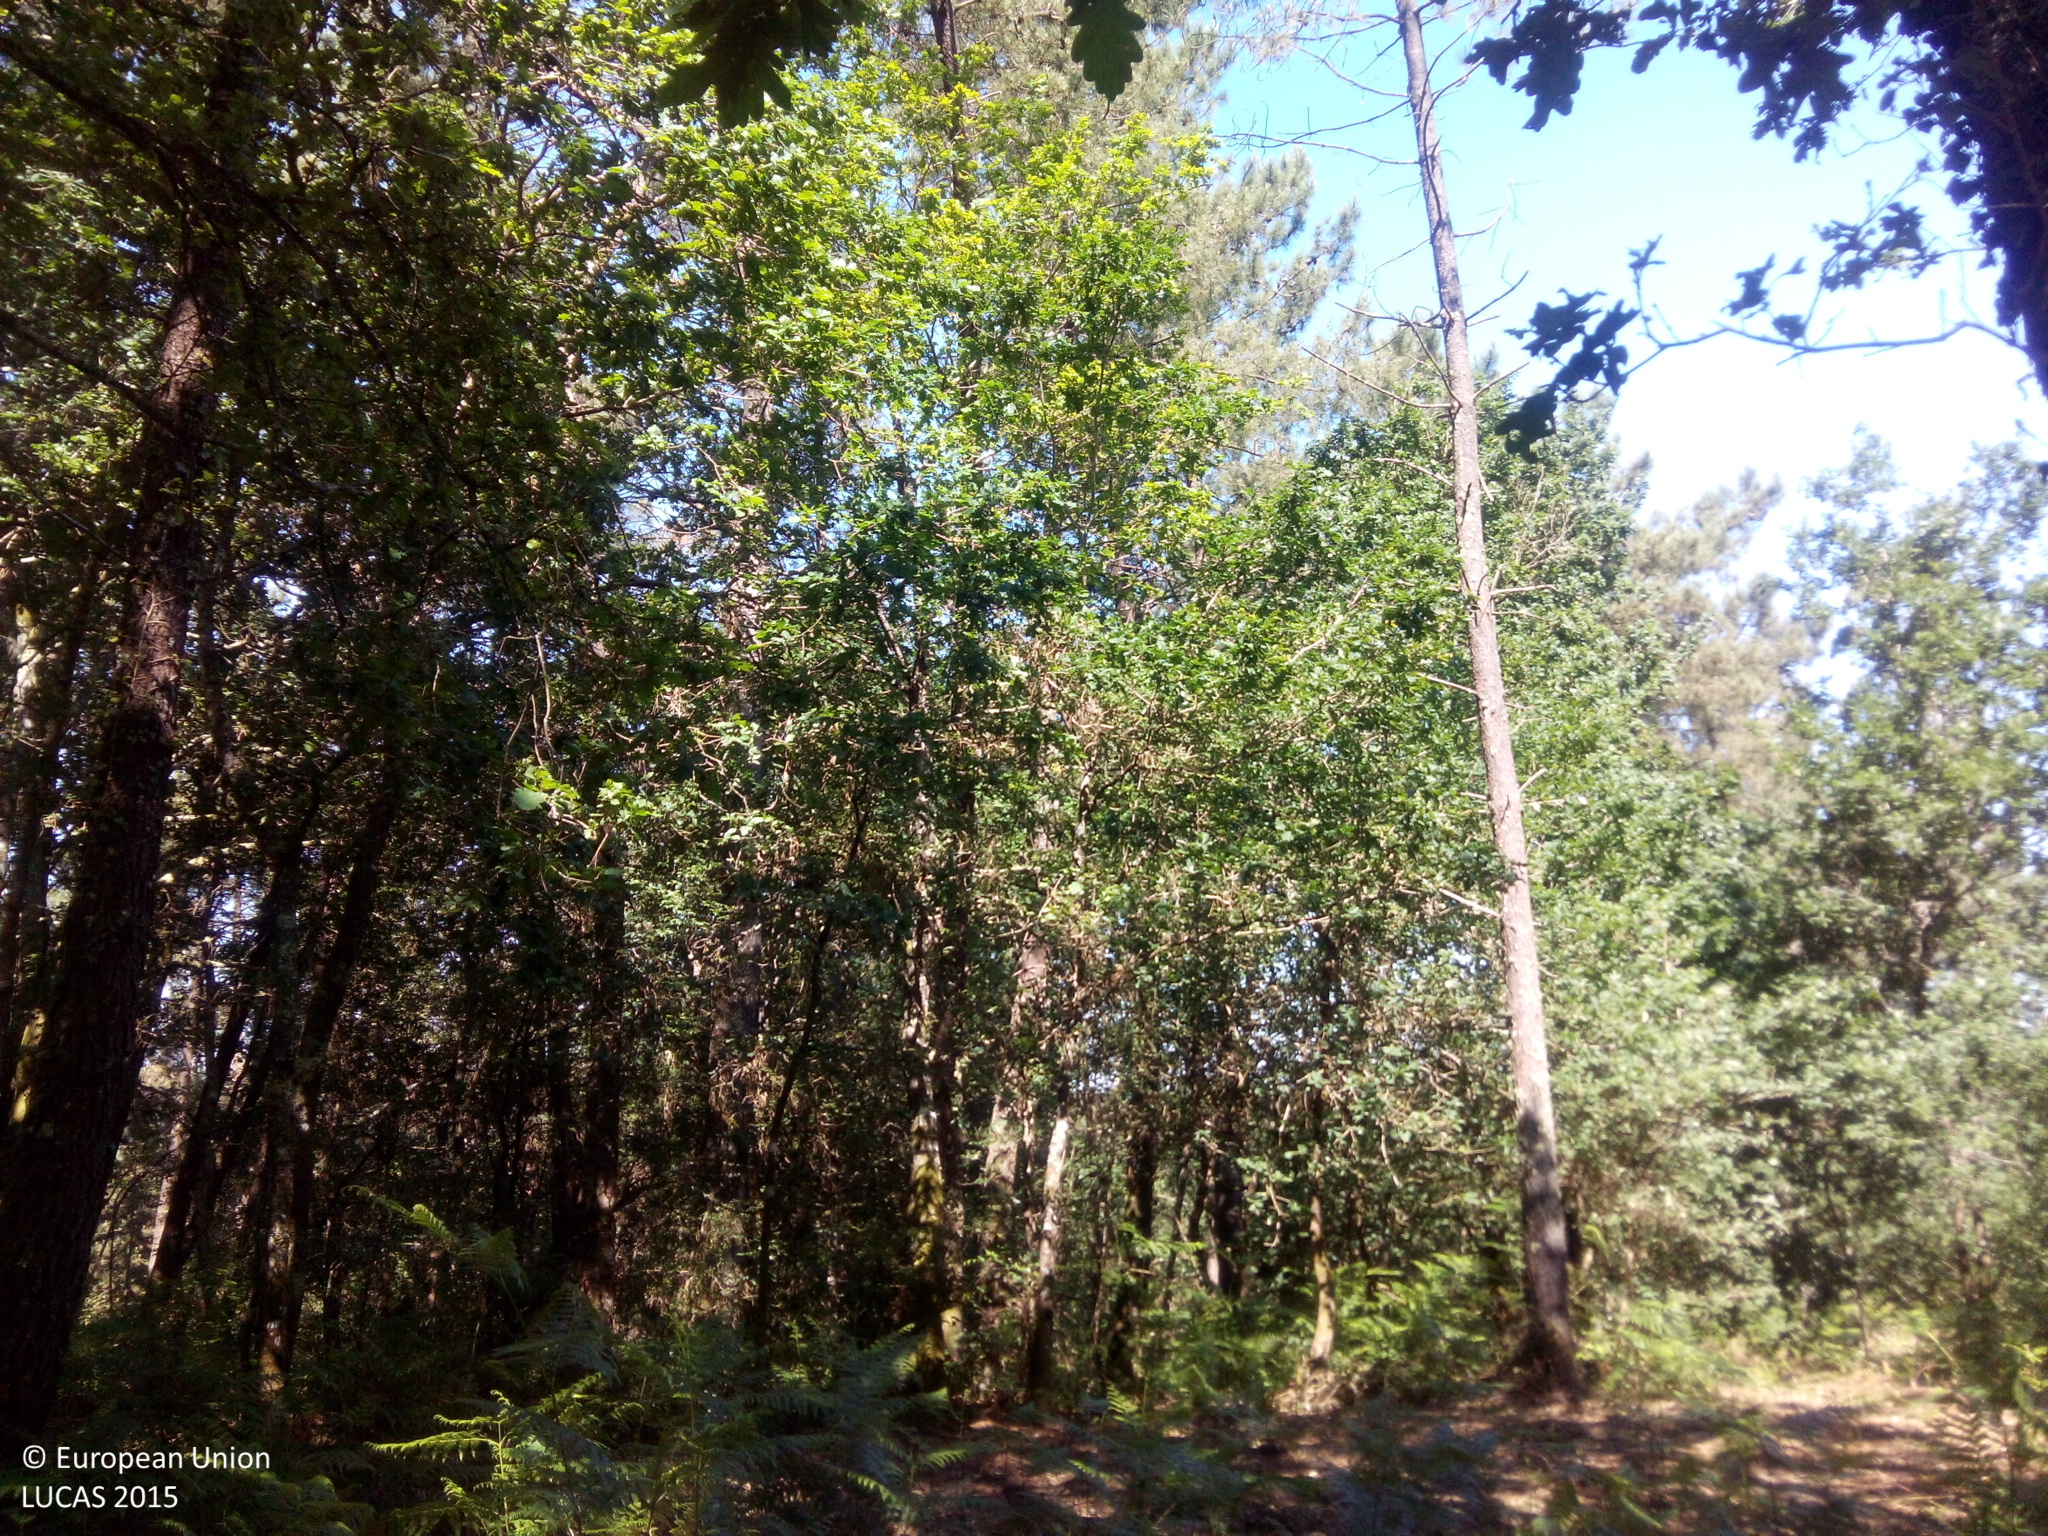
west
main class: Woodland
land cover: Broadleaved woodland
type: acidophilous oak and oak-birch forest
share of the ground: > 75 %
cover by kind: broadleaved forest trees 80 %, shrubs 20 %
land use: Forestry
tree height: > 5 m
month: May
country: ES
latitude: 42.7758
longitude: -8.5218
